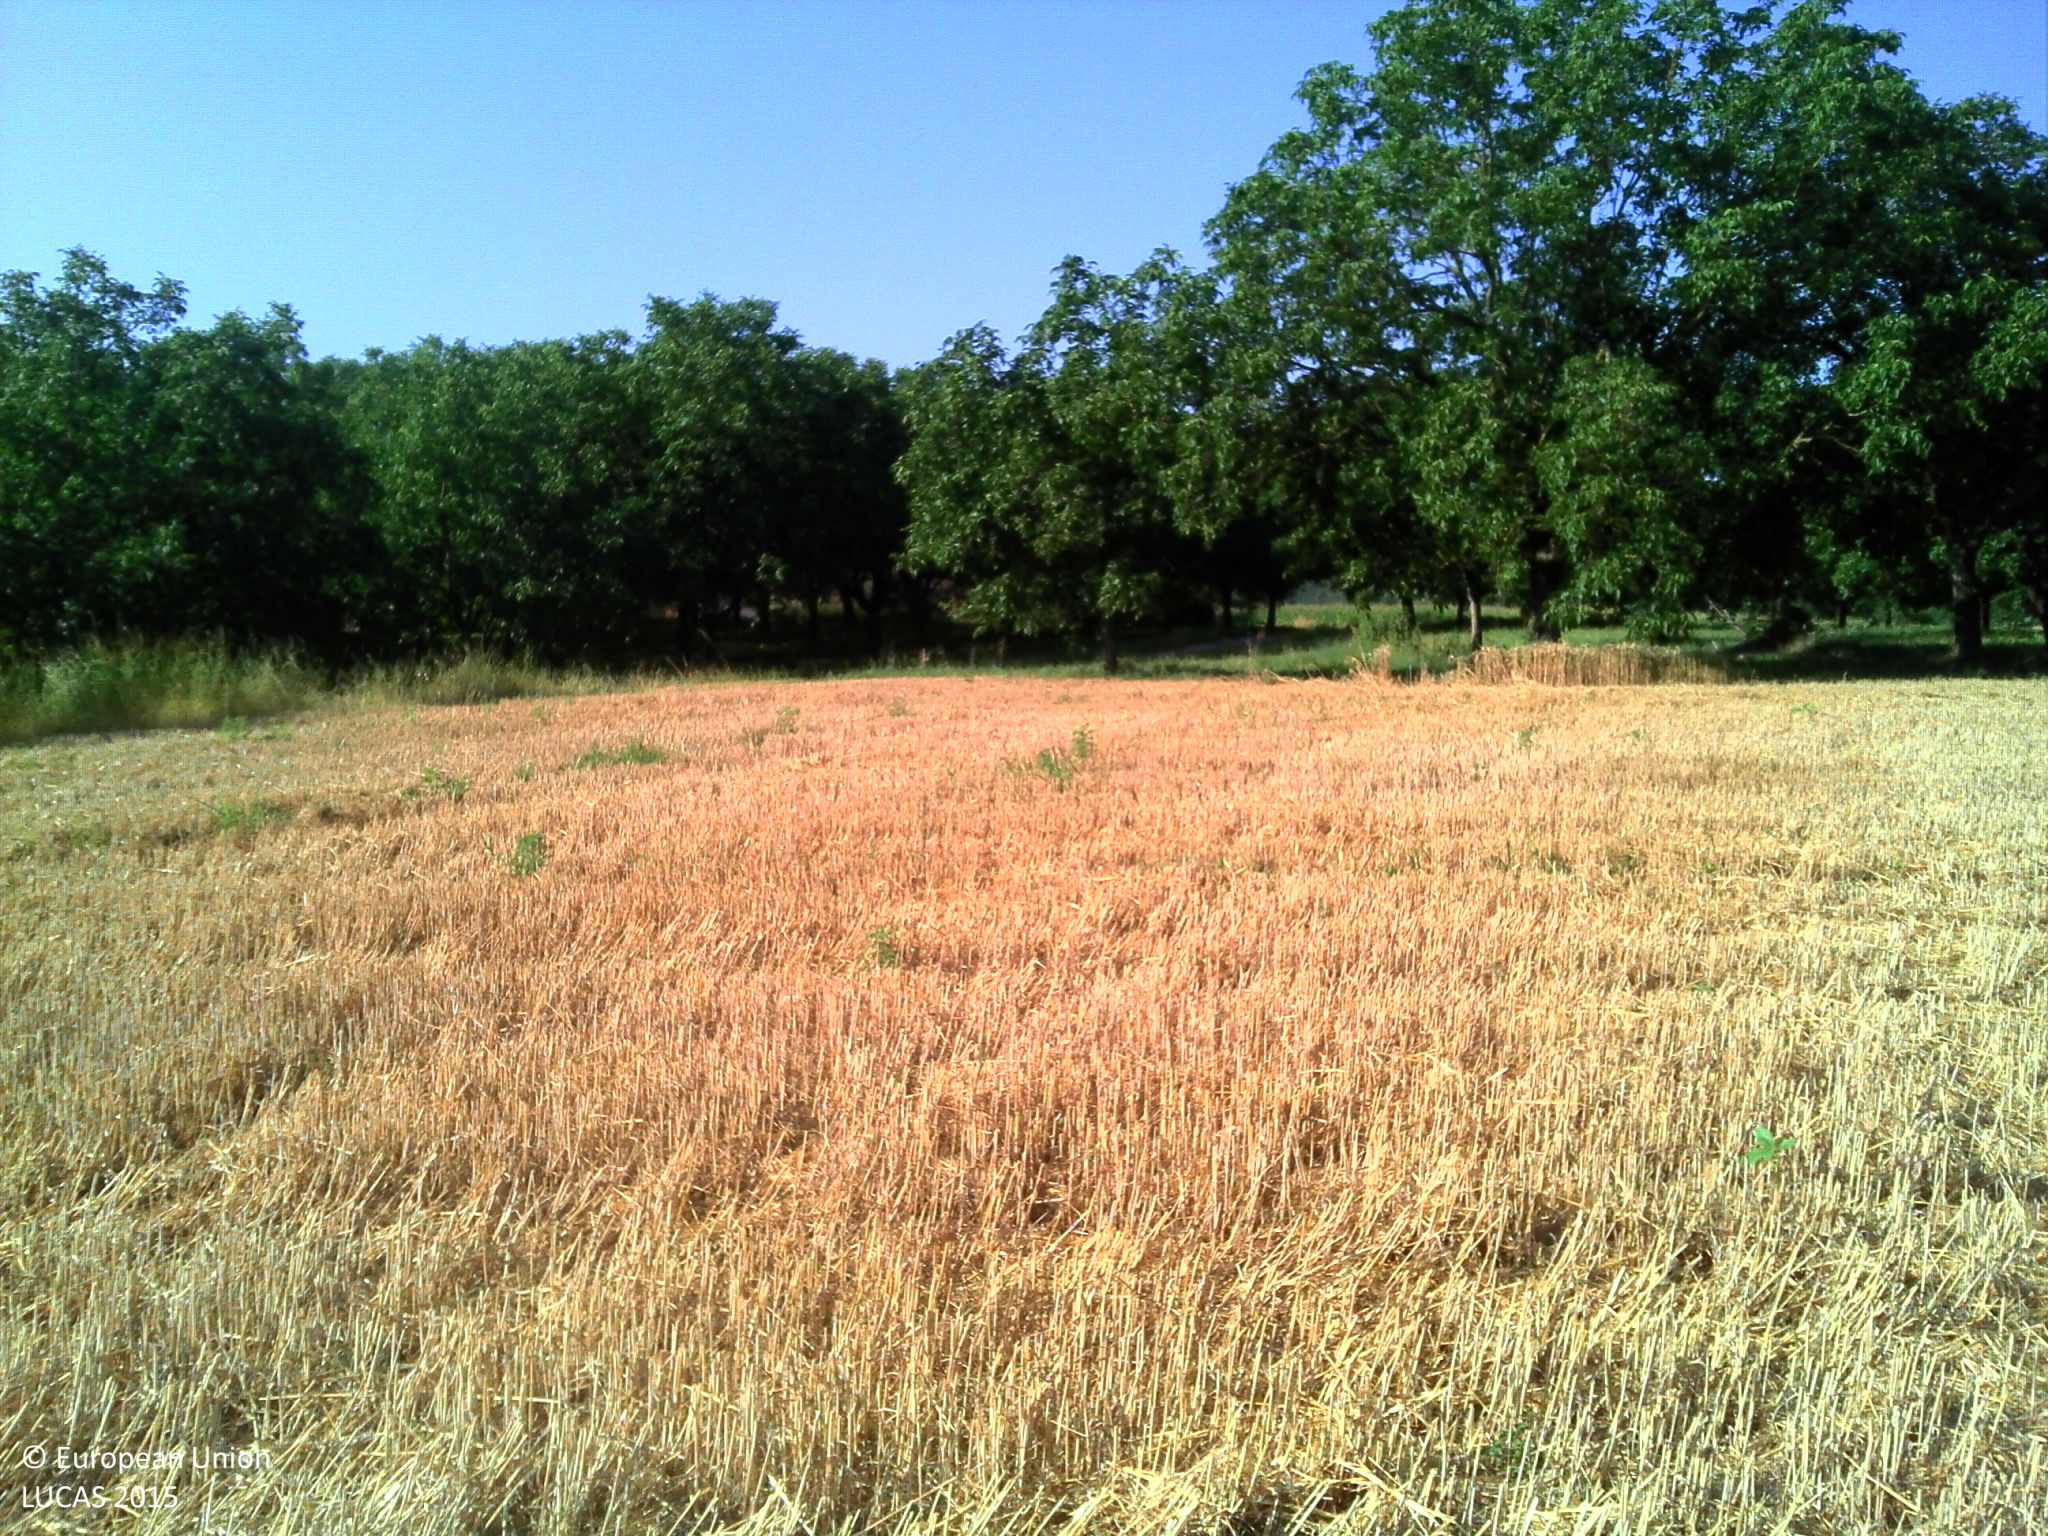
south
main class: Cropland
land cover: Durum wheat
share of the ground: > 75 %
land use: Agriculture (excluding fallow land and kitchen gardens)
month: July
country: FR
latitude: 45.1071
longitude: 5.2139
